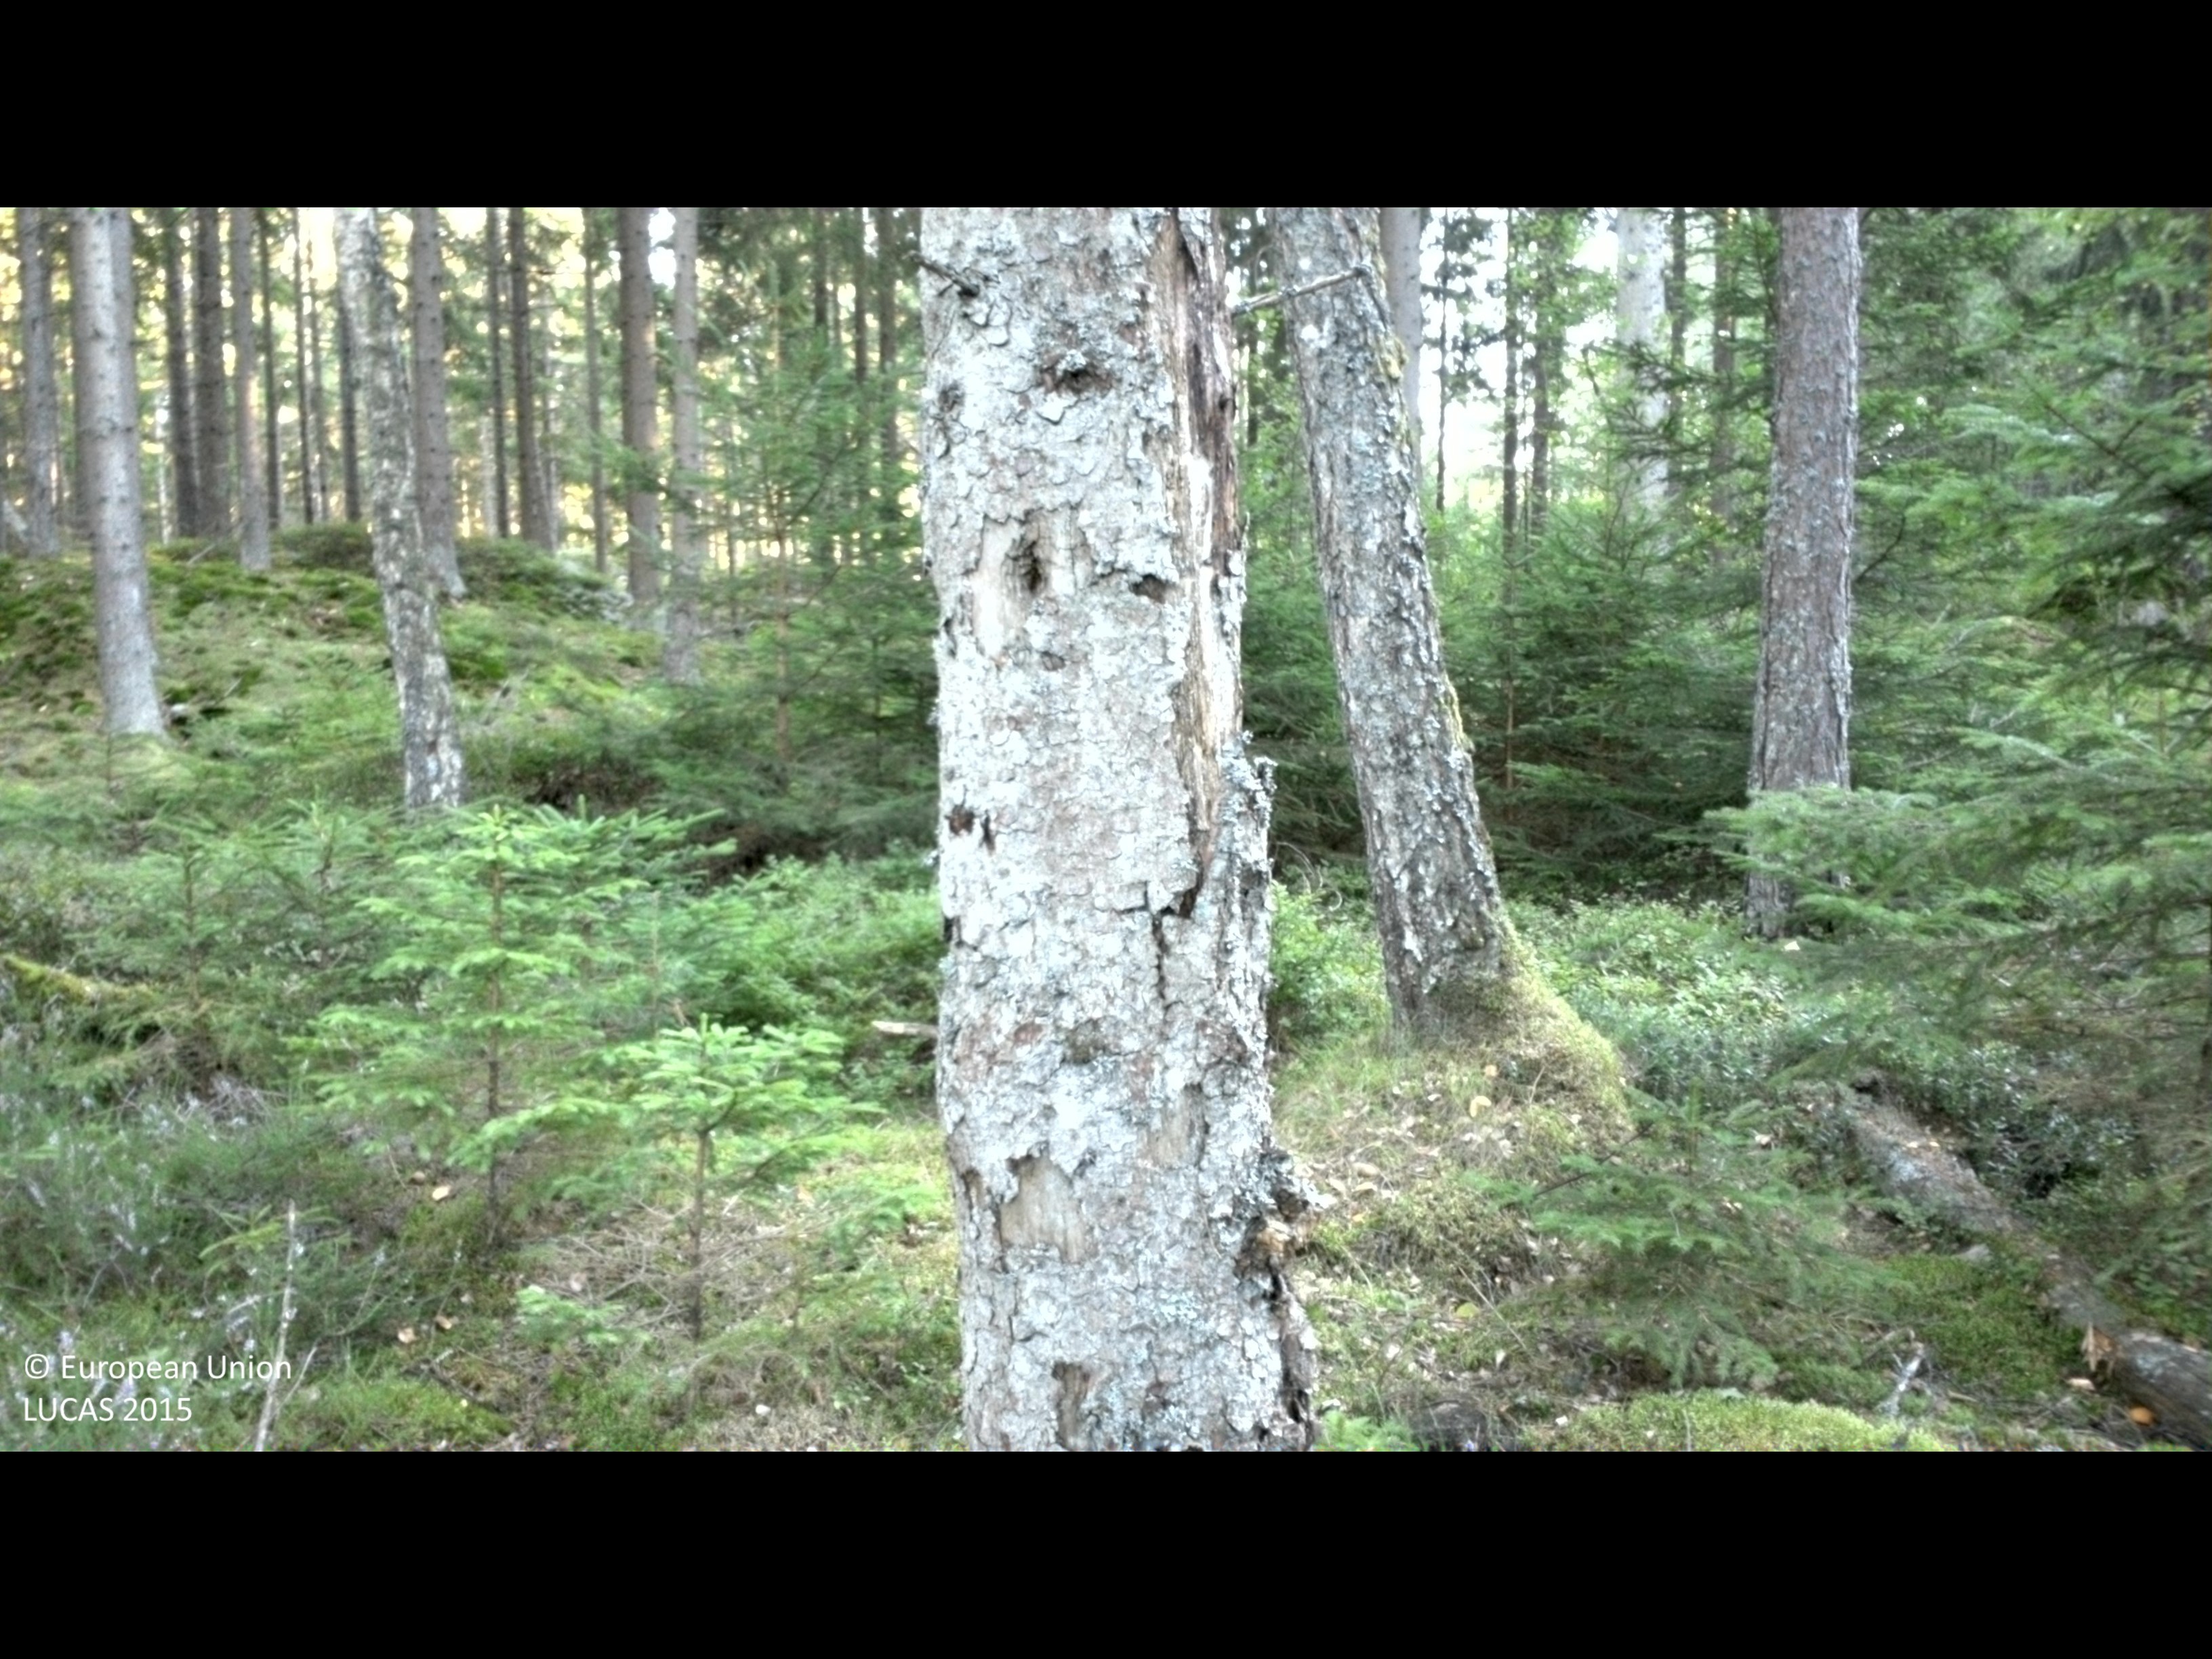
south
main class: Woodland
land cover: Spruce dominated coniferous woodland
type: boreal forest
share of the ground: > 75 %
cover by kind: coniferous forest trees 75 %, lichens and mosses 25 %
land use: Forestry
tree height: > 5 m
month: September
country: SE
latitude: 56.2394
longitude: 14.3703
